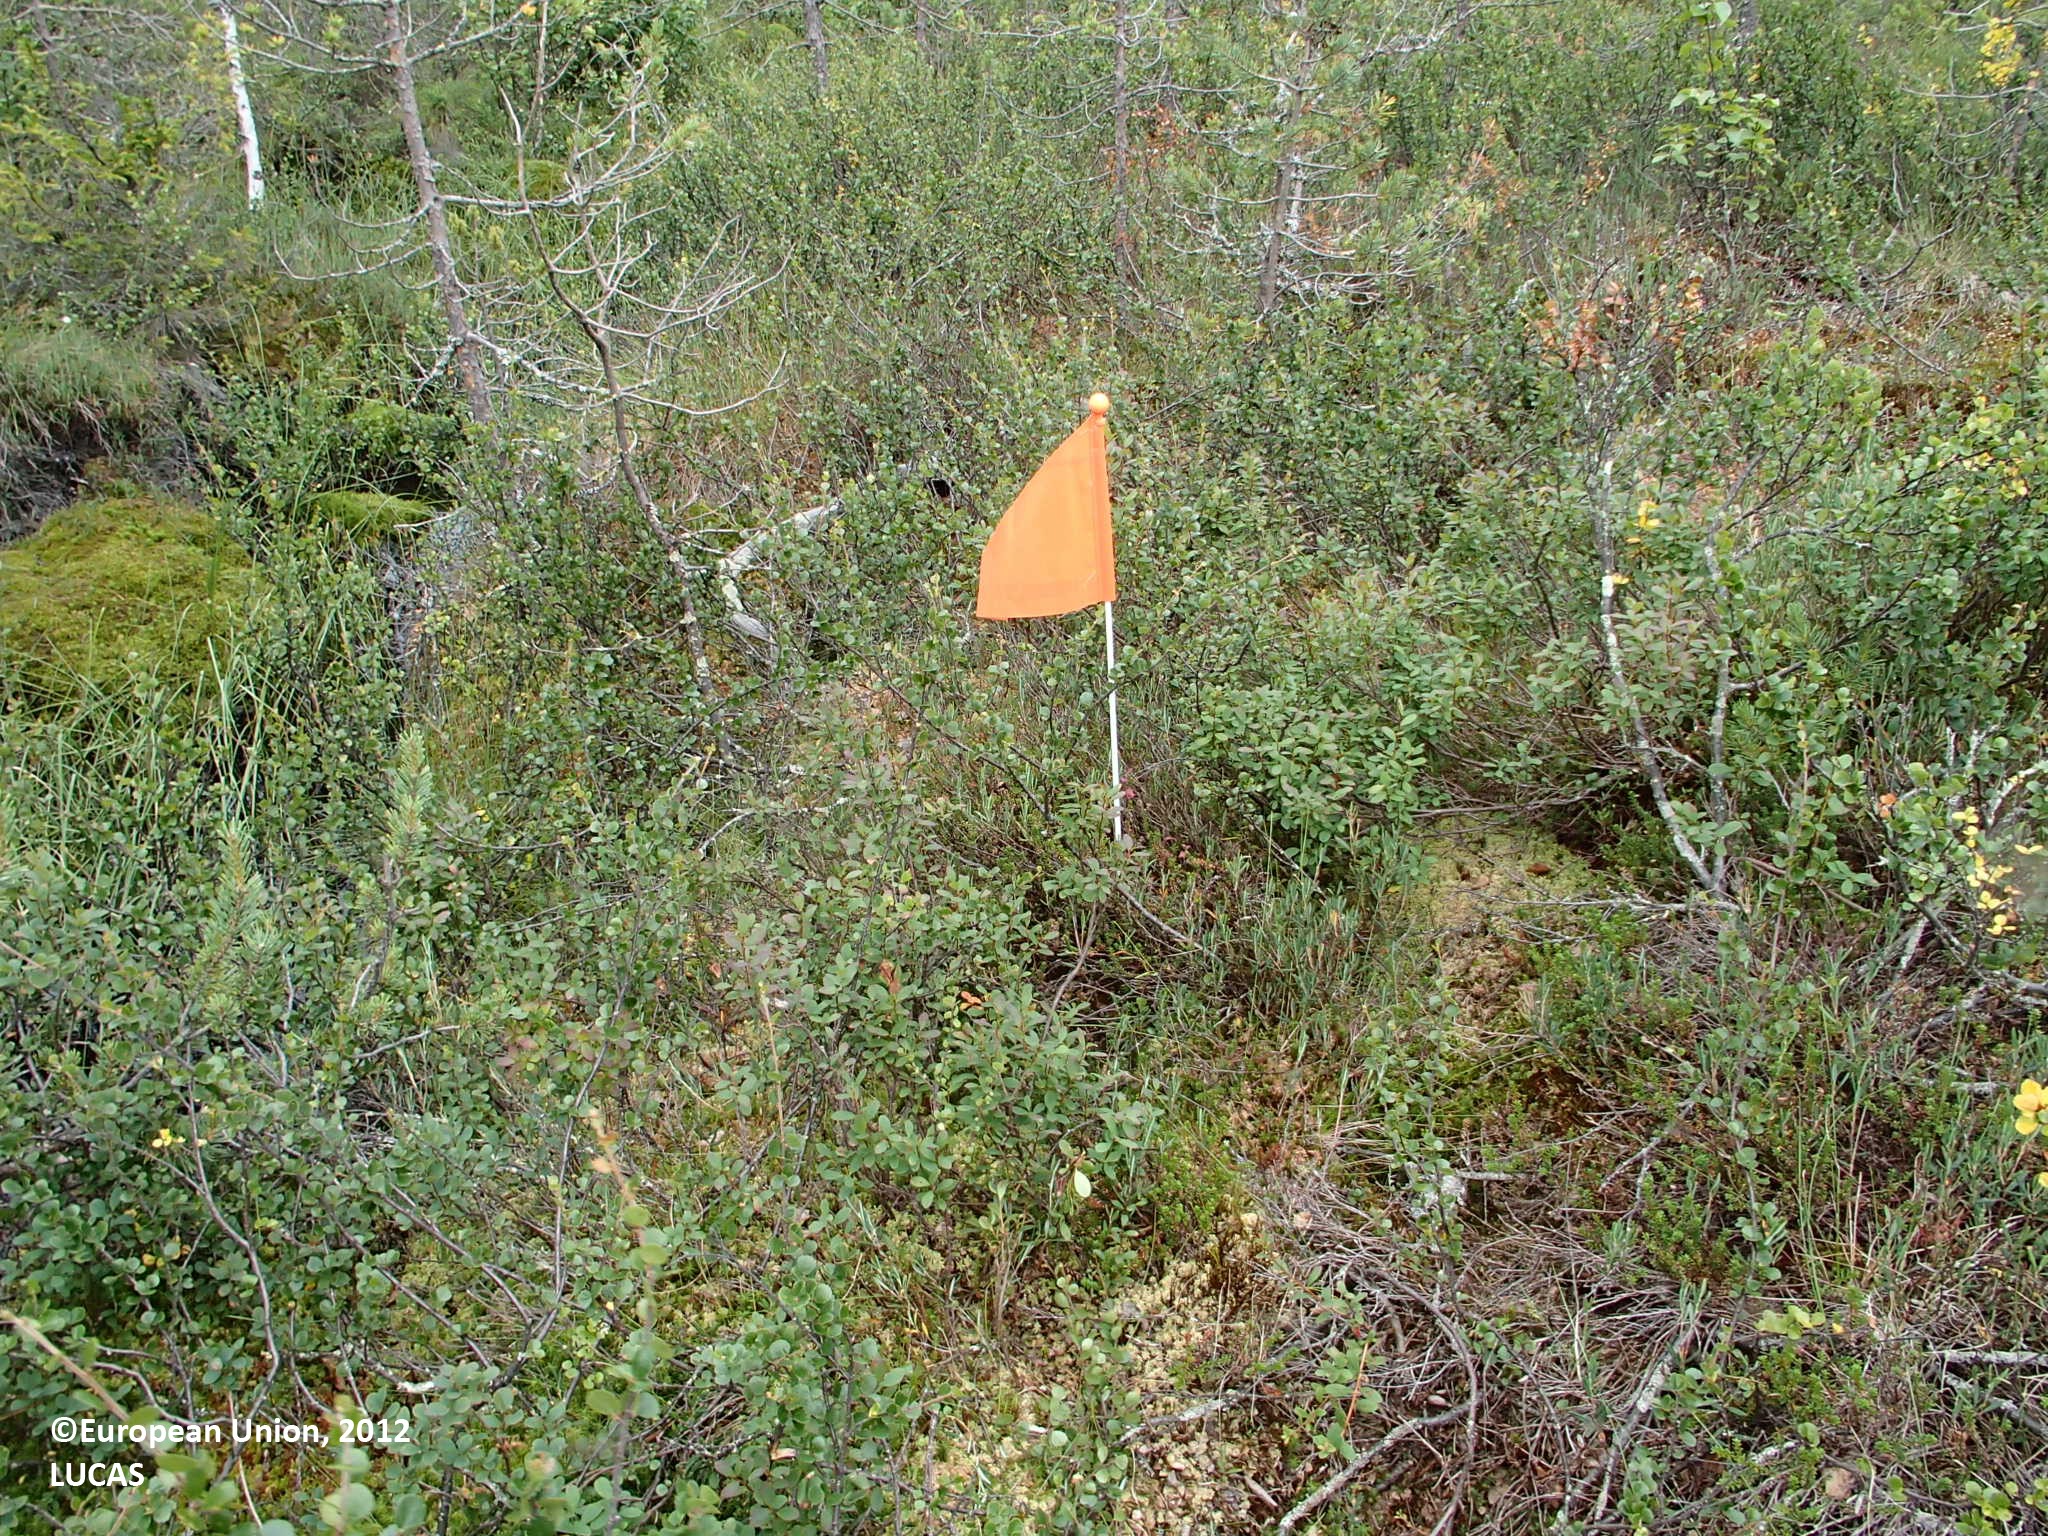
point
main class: Woodland
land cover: Other mixed woodland
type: boreal forest
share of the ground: 50 - 75 %
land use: Forestry
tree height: < 5 m
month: July
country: FI
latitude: 66.6473
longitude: 25.5028
